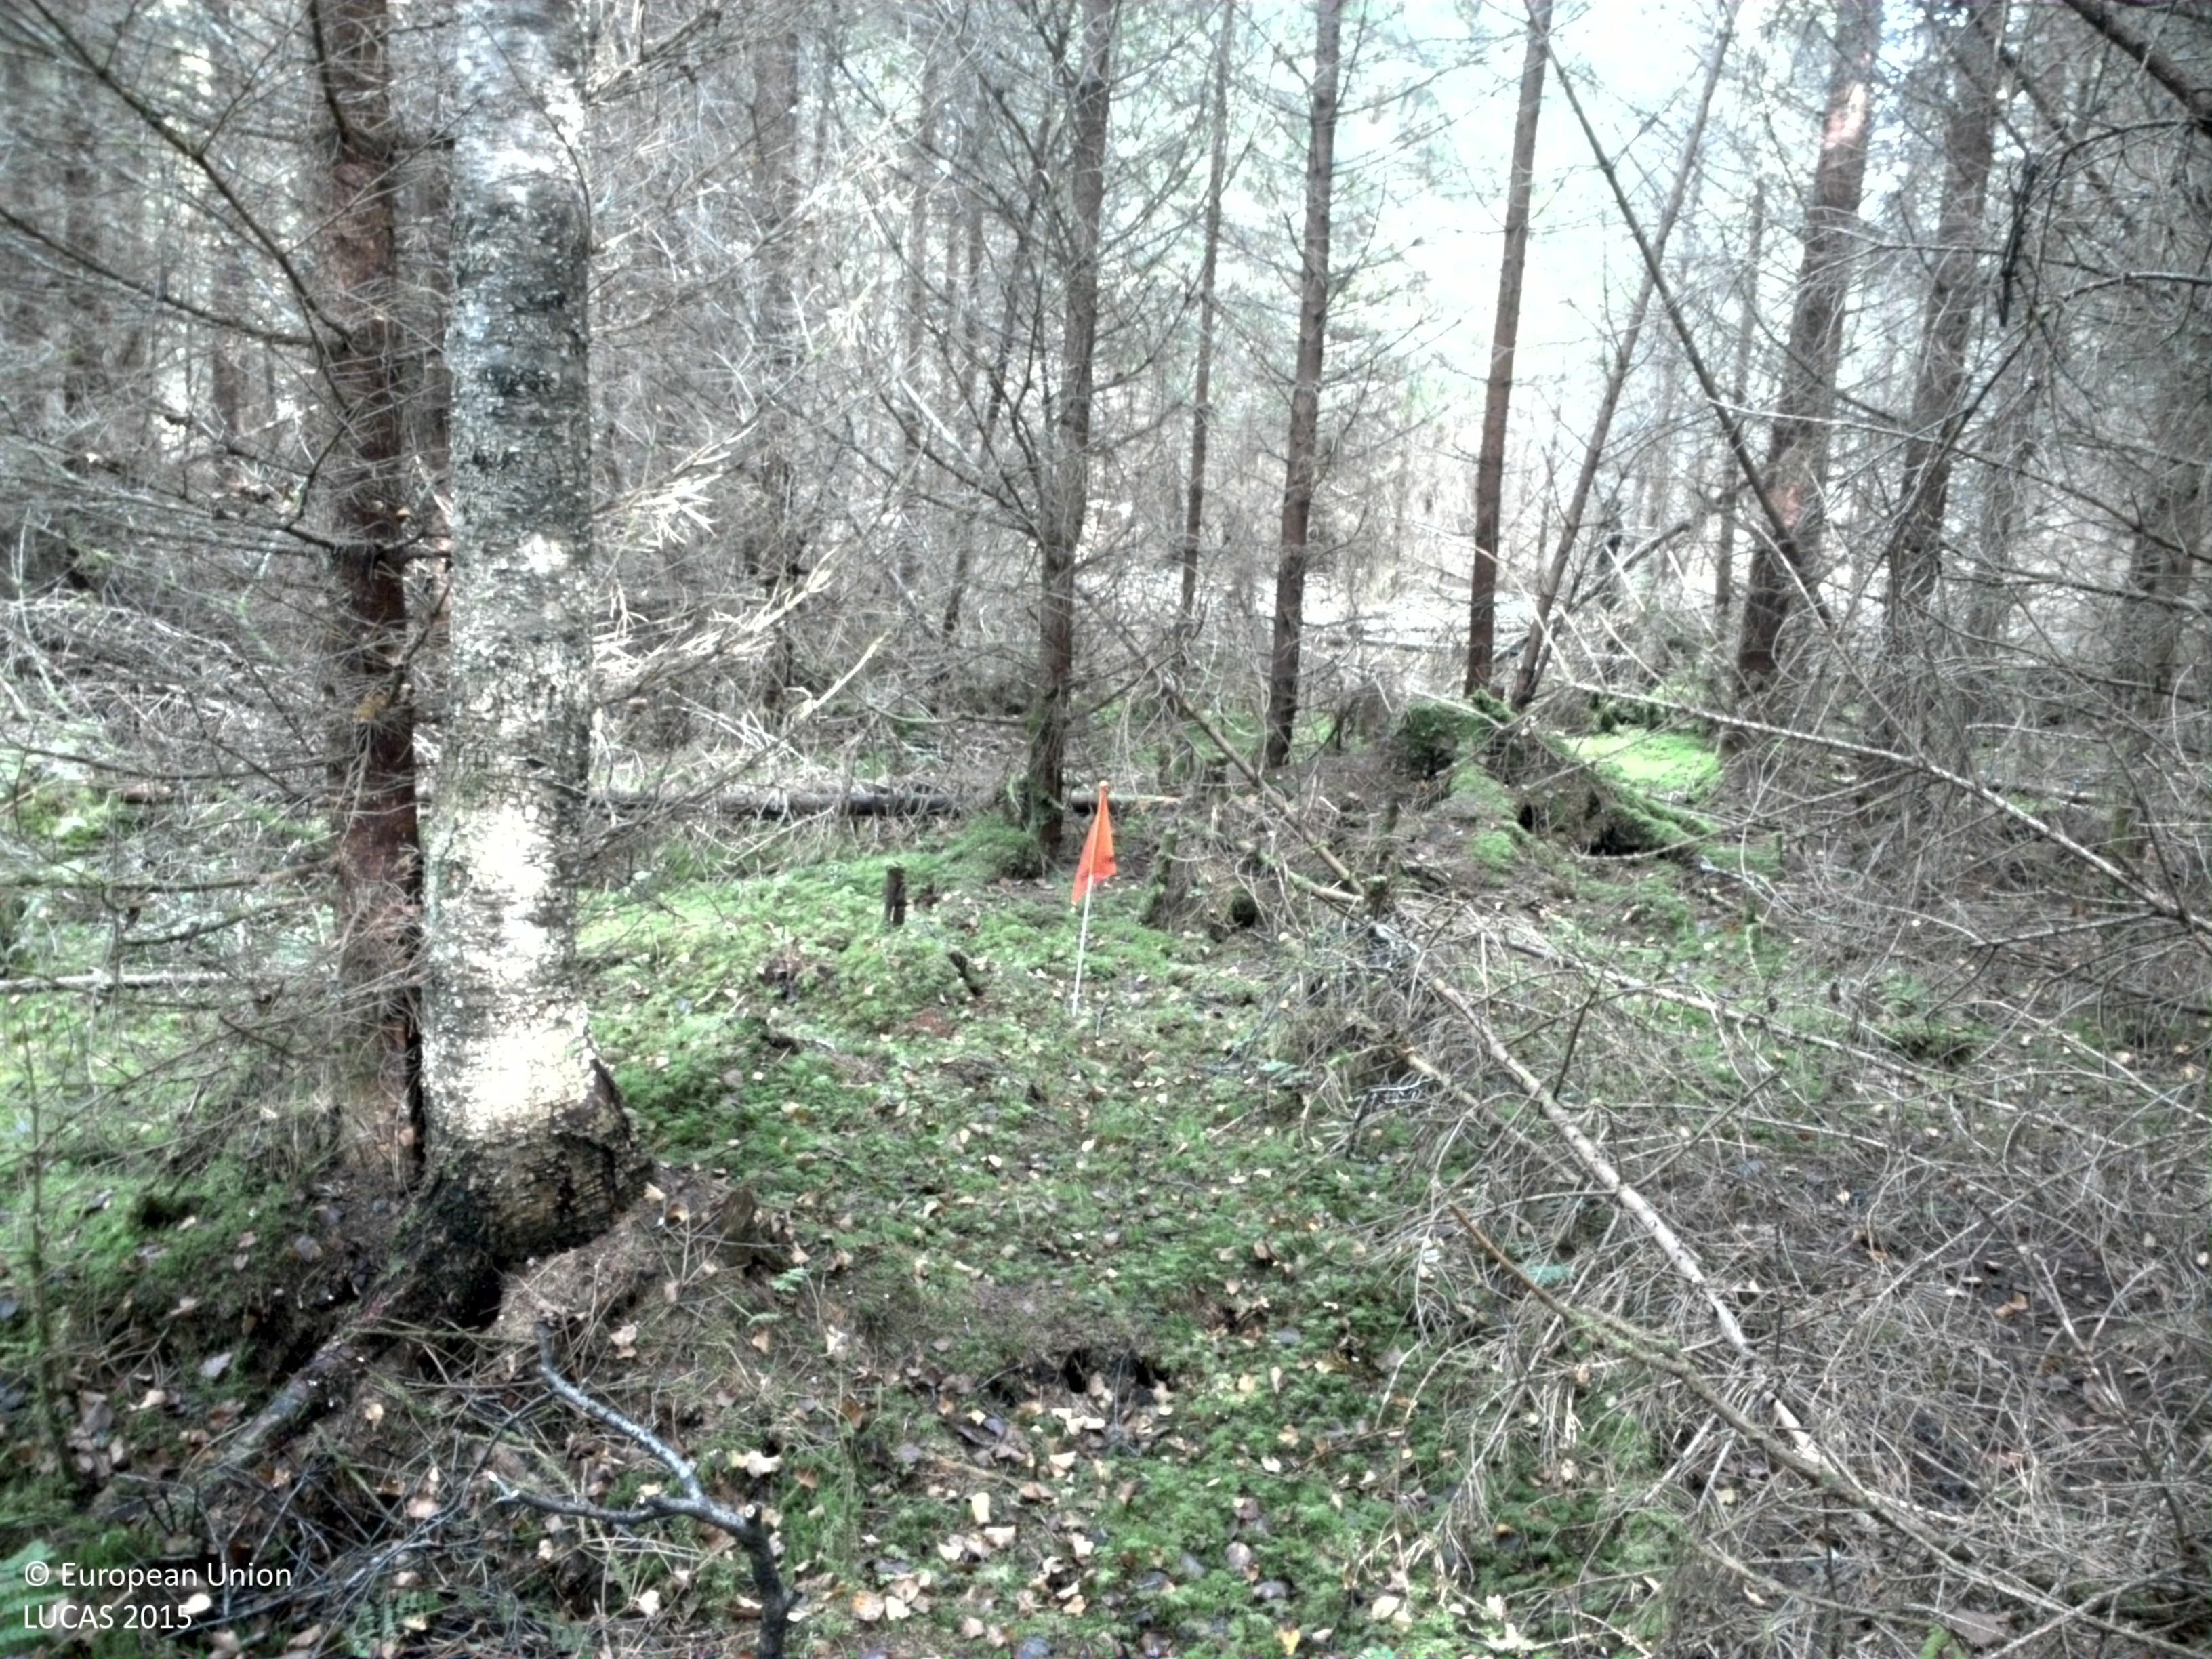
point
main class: Woodland
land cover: Spruce dominated coniferous woodland
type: boreal forest
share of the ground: 50 - 75 %
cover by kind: coniferous forest trees 60 %, lichens and mosses 35 %, broadleaved forest trees 5 %
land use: Forestry
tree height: > 5 m
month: September
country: SE
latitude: 59.1288
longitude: 14.1331
